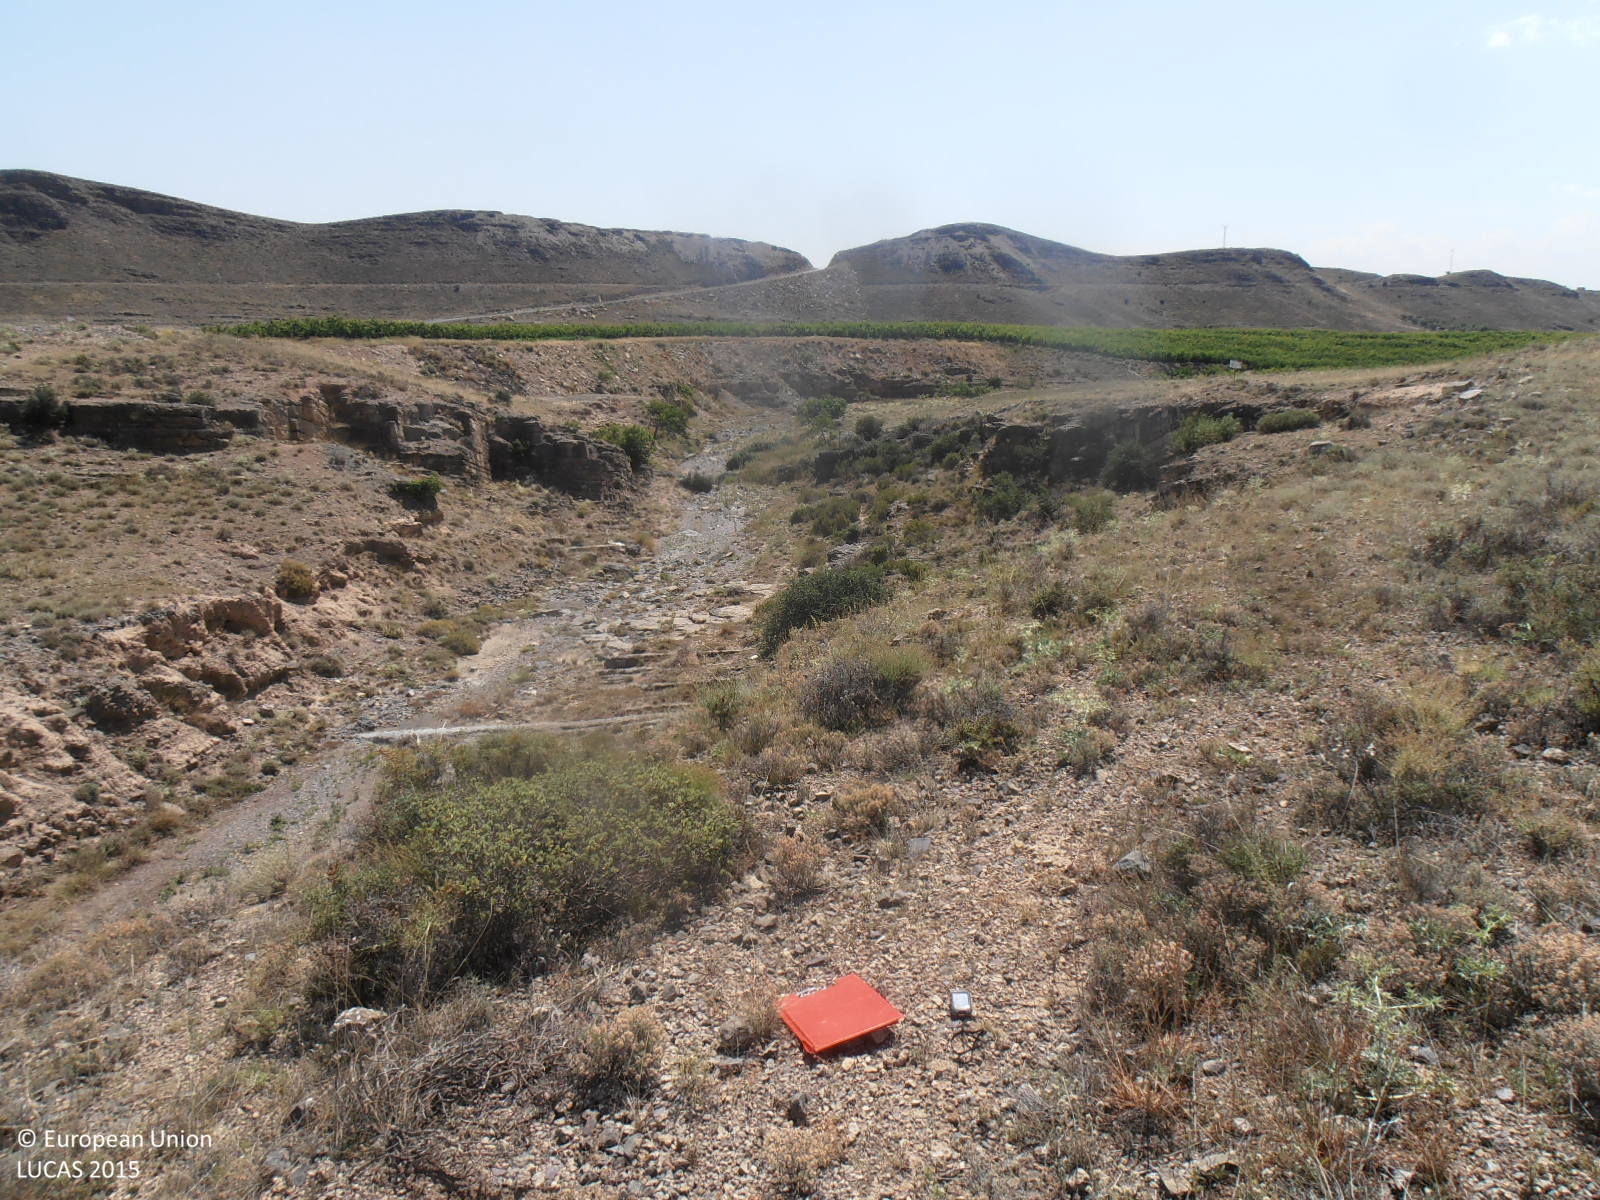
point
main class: Shrubland
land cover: Shrubland without tree cover
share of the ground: 25 - 50 %
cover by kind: consolidated bare surface 55 %, shrubs 40 %, herbaceous plants 5 %
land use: Semi-natural and natural areas not in use
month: June
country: ES
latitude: 41.5138
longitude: -1.4198
